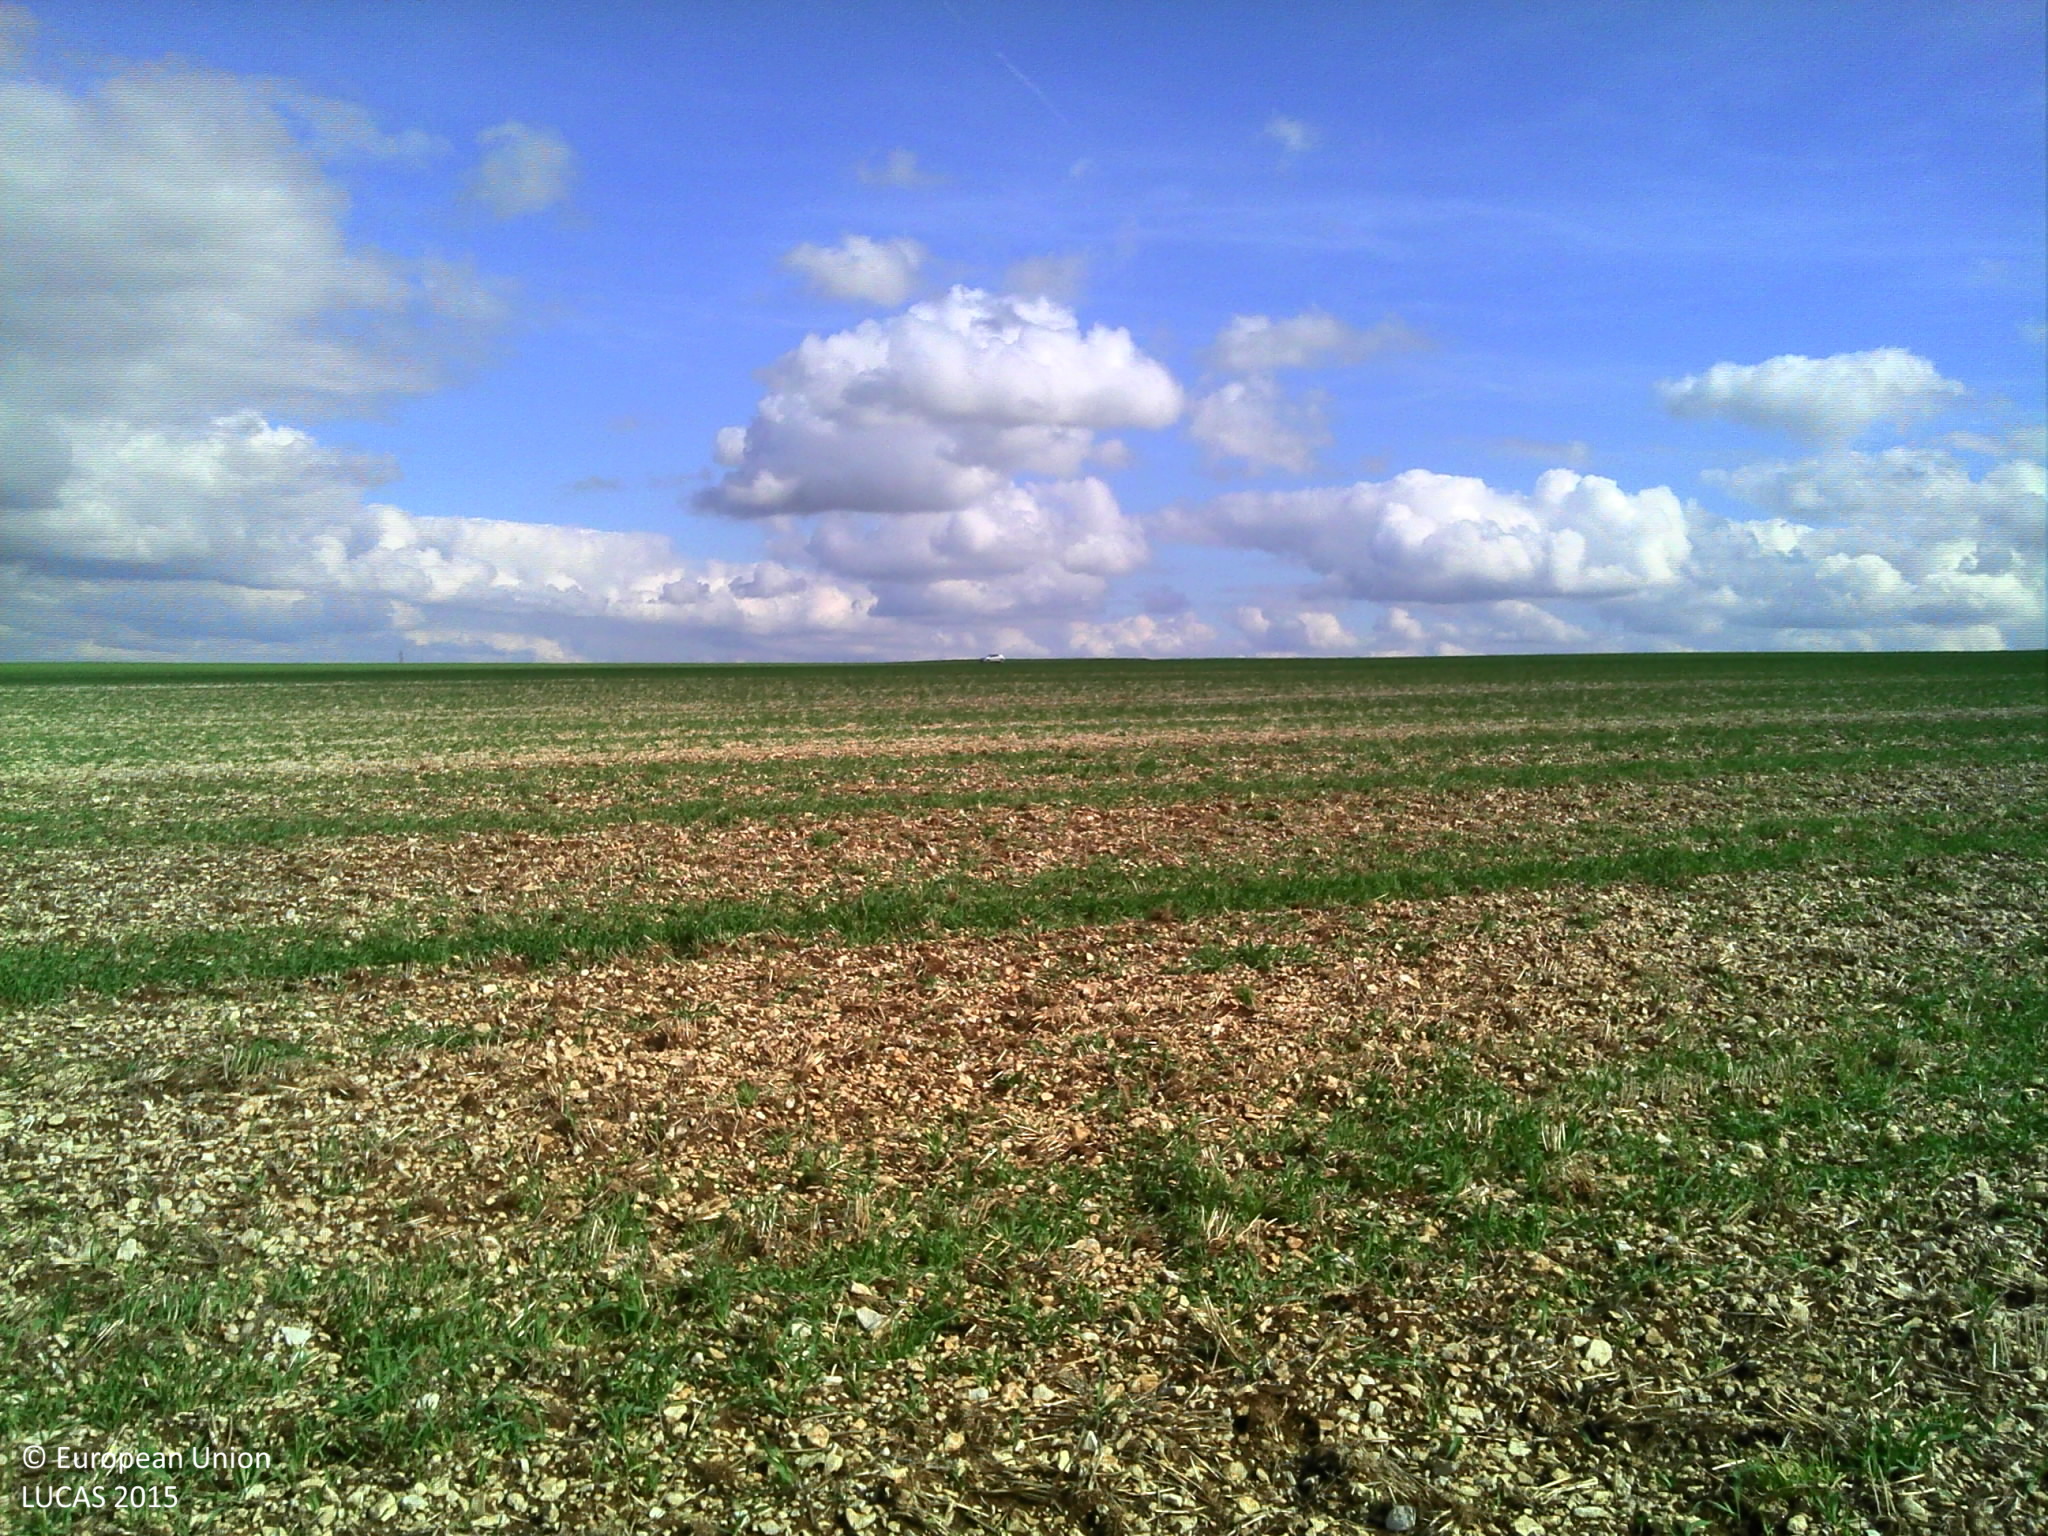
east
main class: Cropland
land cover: Barley
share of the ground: > 75 %
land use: Agriculture (excluding fallow land and kitchen gardens)
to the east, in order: Barley; Rape and turnip rape
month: September
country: FR
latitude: 48.0371
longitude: 4.2435
